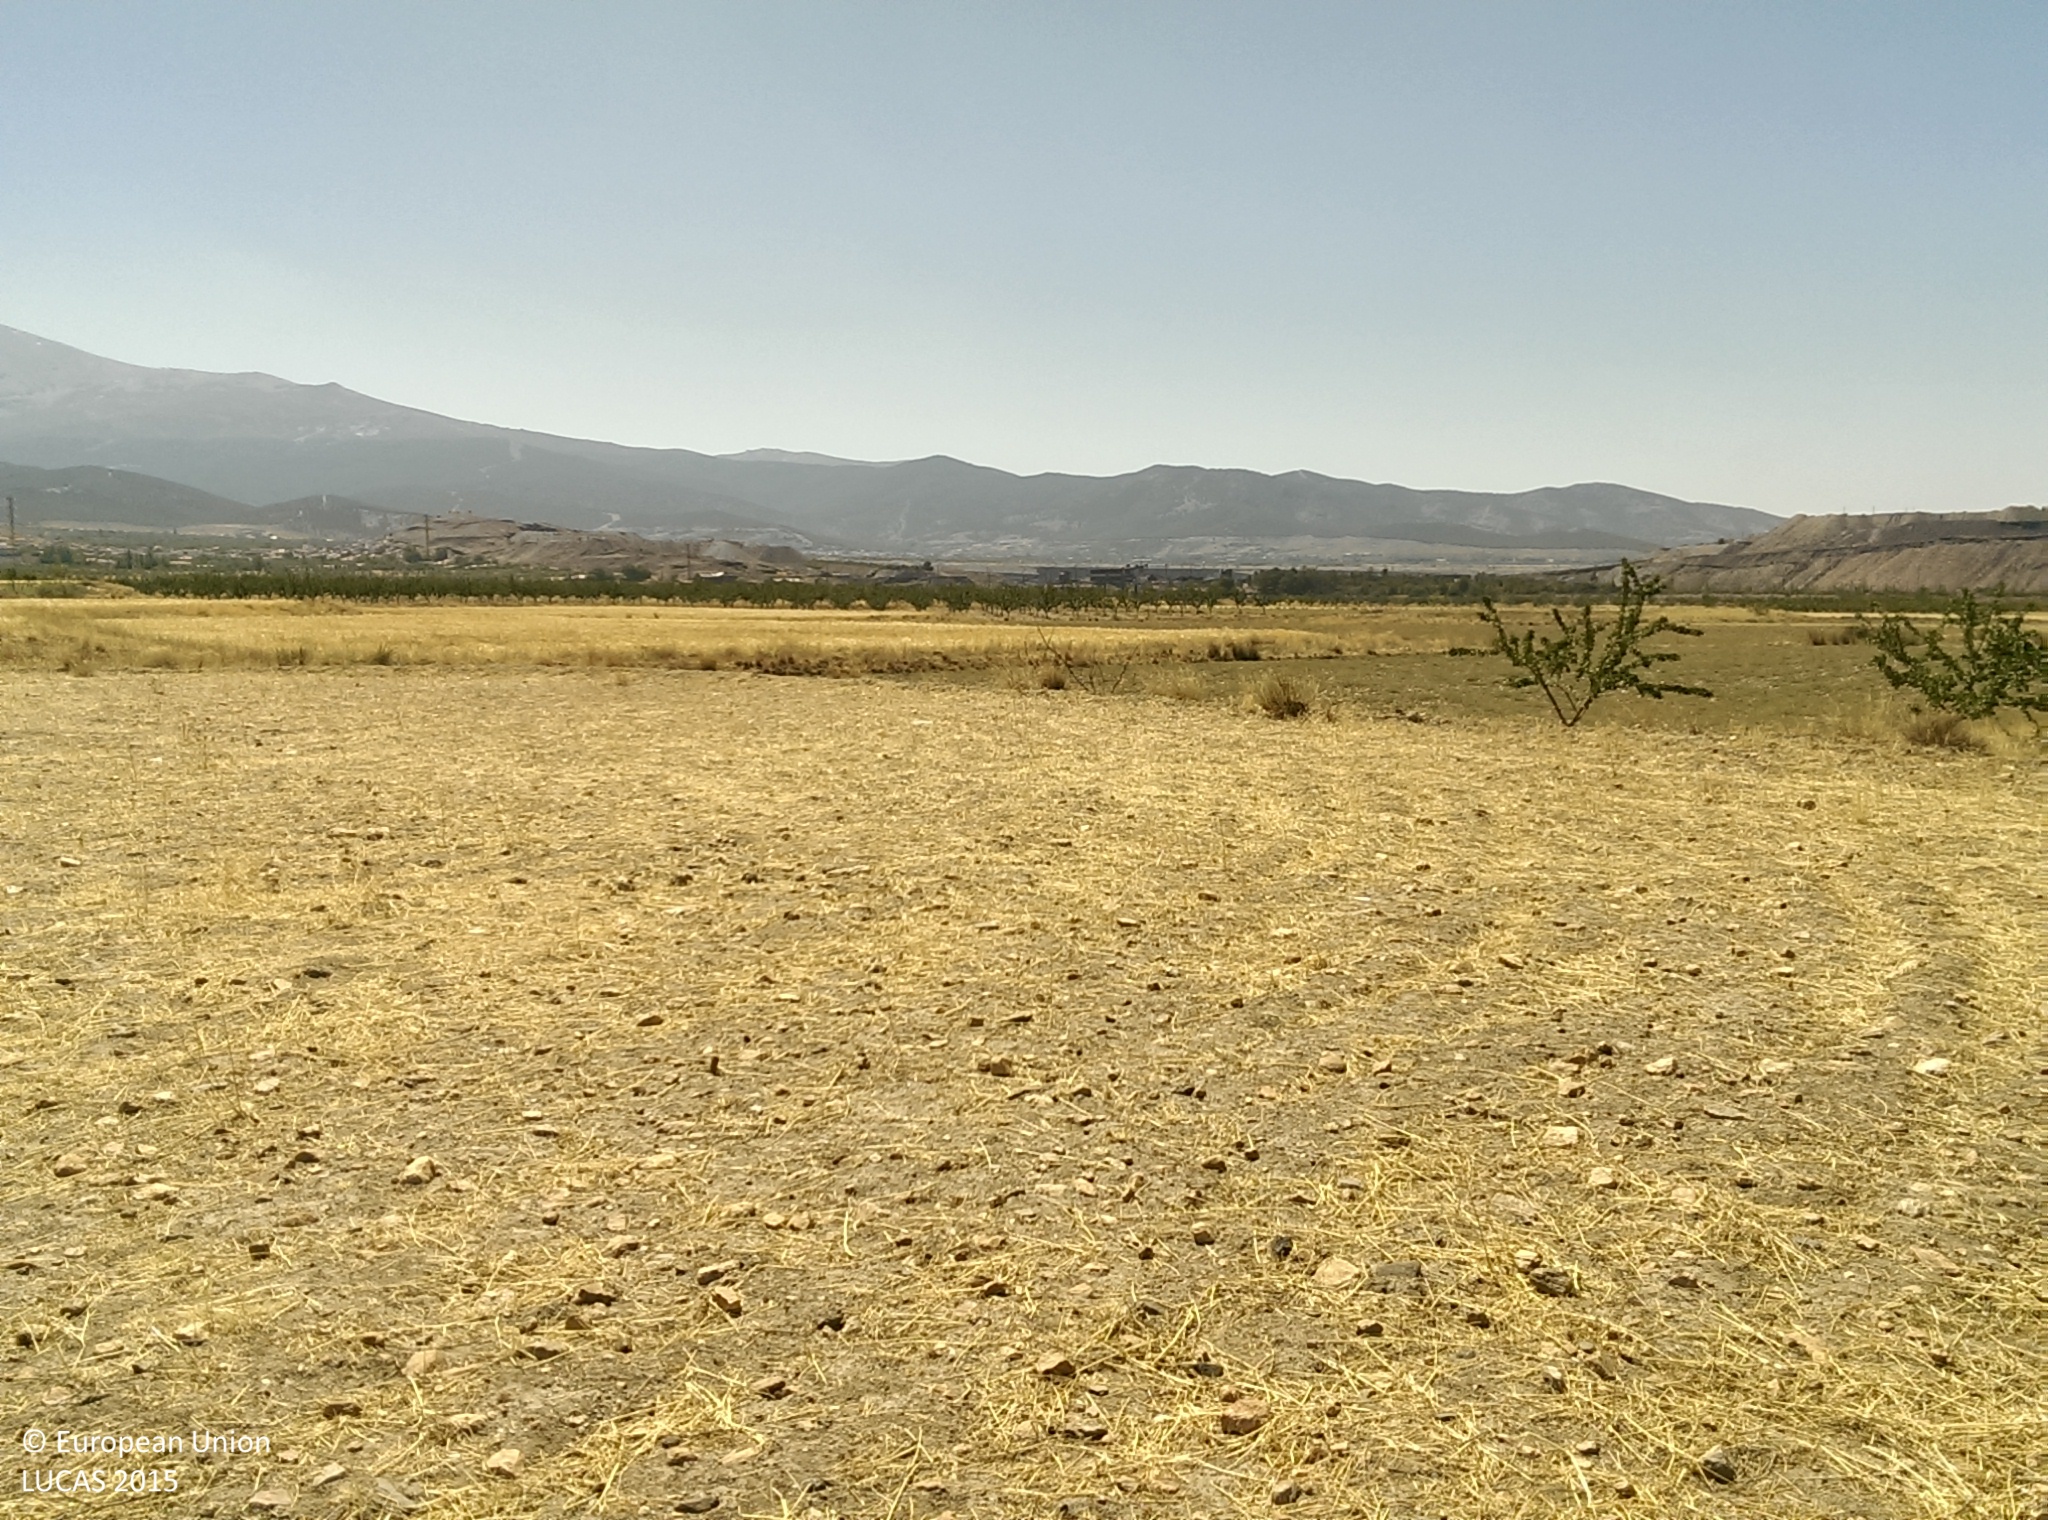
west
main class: Cropland
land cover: Barley
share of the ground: < 10 %
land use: Agriculture (excluding fallow land and kitchen gardens)
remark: Harvested field
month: July
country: ES
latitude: 37.1877
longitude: -3.0858
